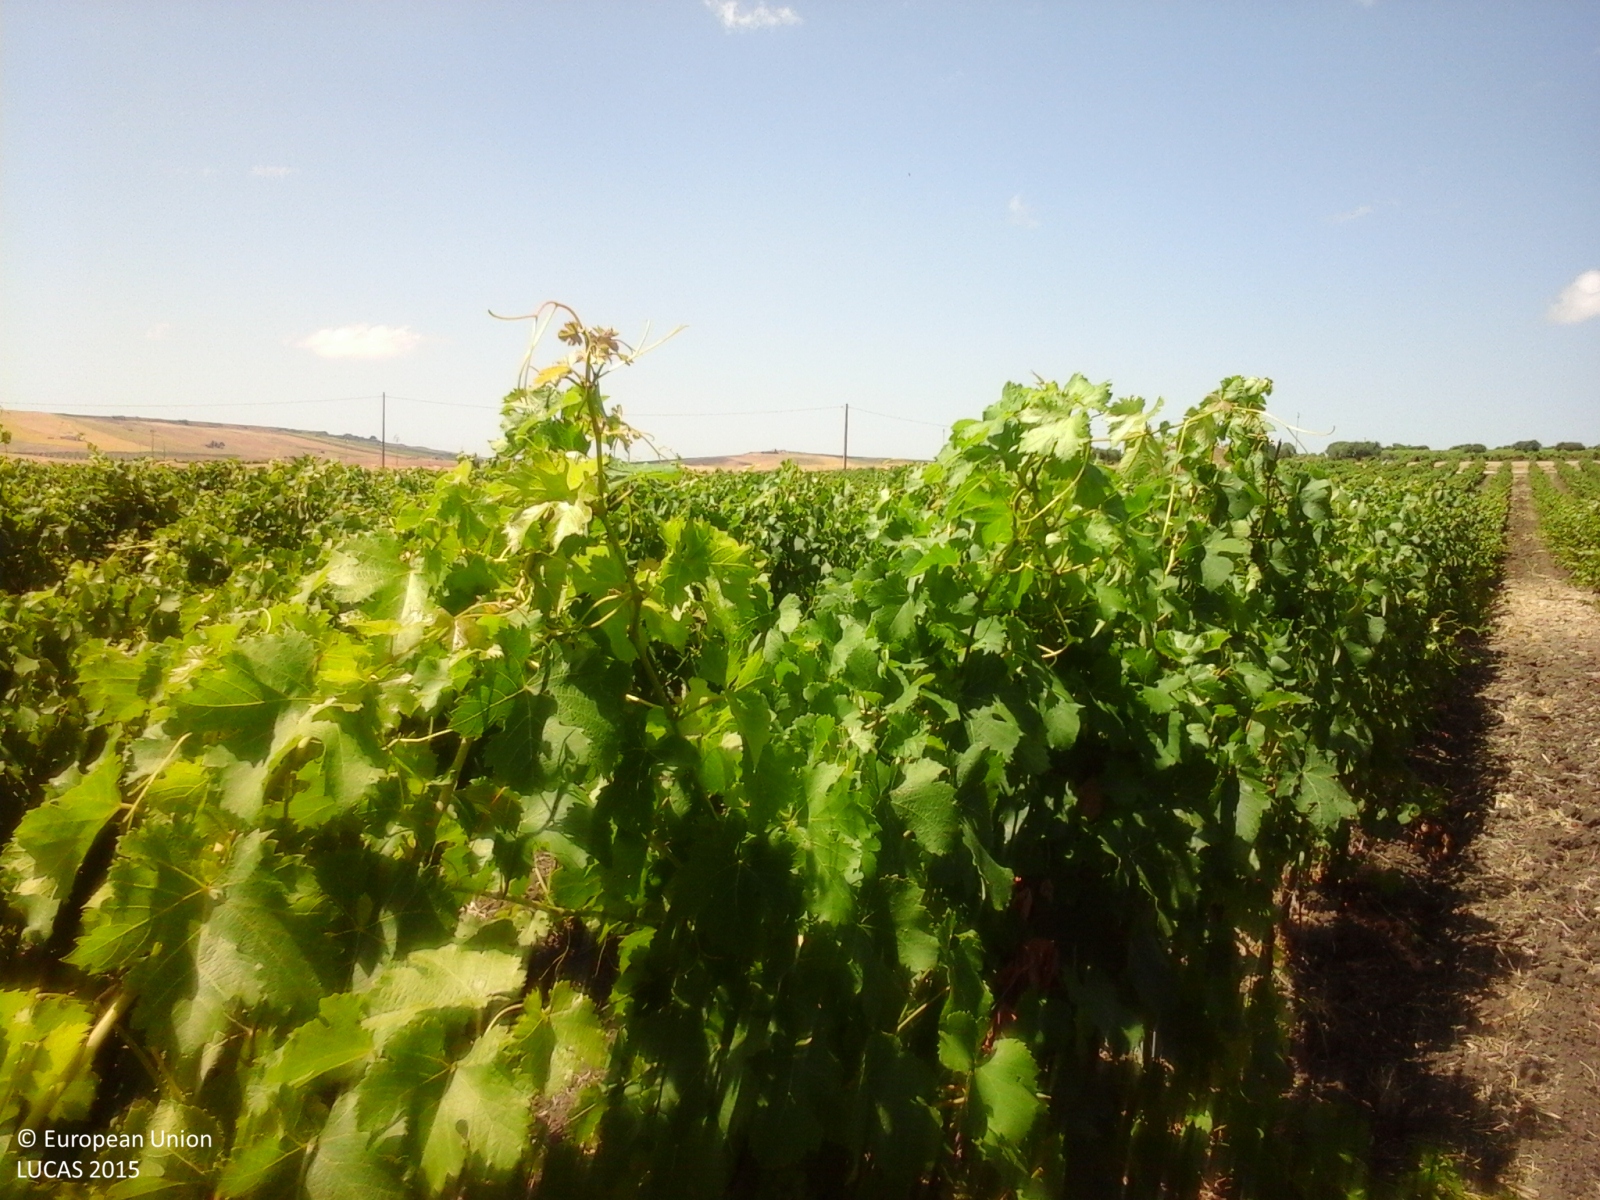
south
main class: Cropland
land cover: Vineyards
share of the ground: 25 - 50 %
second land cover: Other bare soil
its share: > 75 %
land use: Agriculture (excluding fallow land and kitchen gardens)
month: June
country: IT
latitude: 37.7639
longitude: 12.6929
